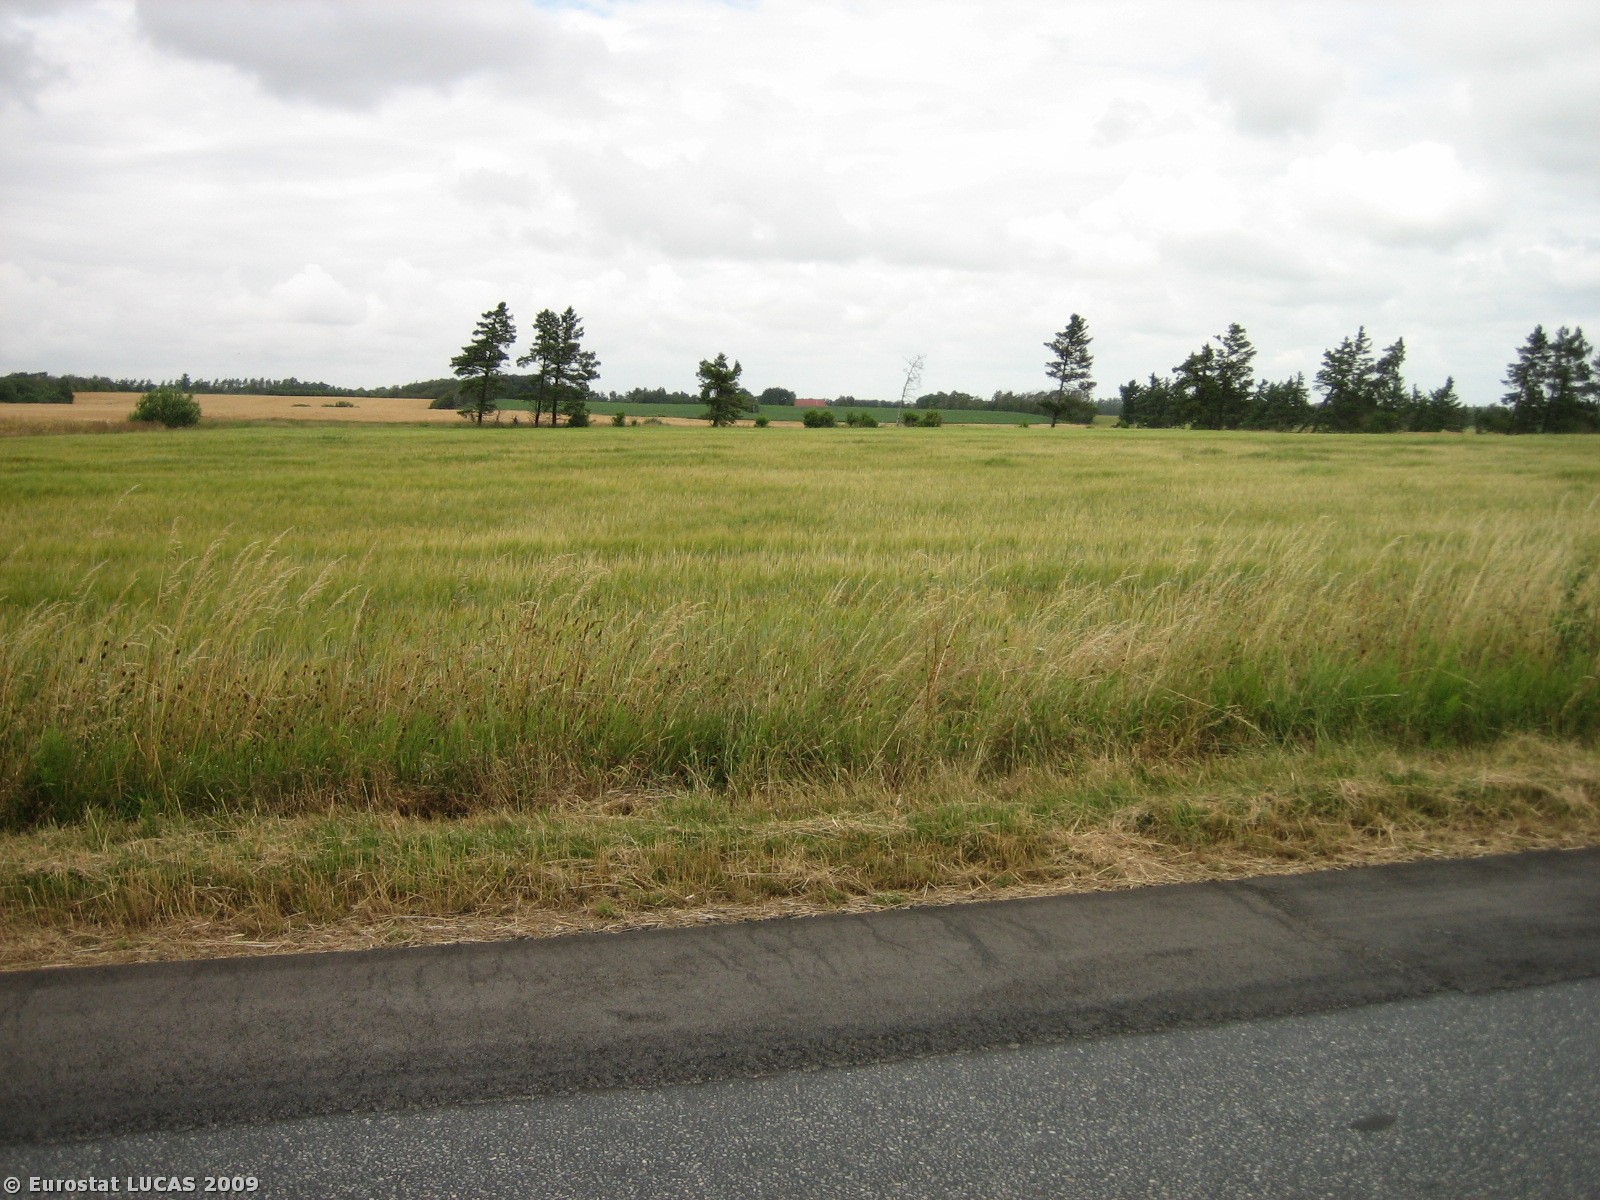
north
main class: Cropland
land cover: Barley
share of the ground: > 75 %
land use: Agriculture (excluding fallow land and kitchen gardens)
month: July
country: DK
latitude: 55.8559
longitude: 8.5477
